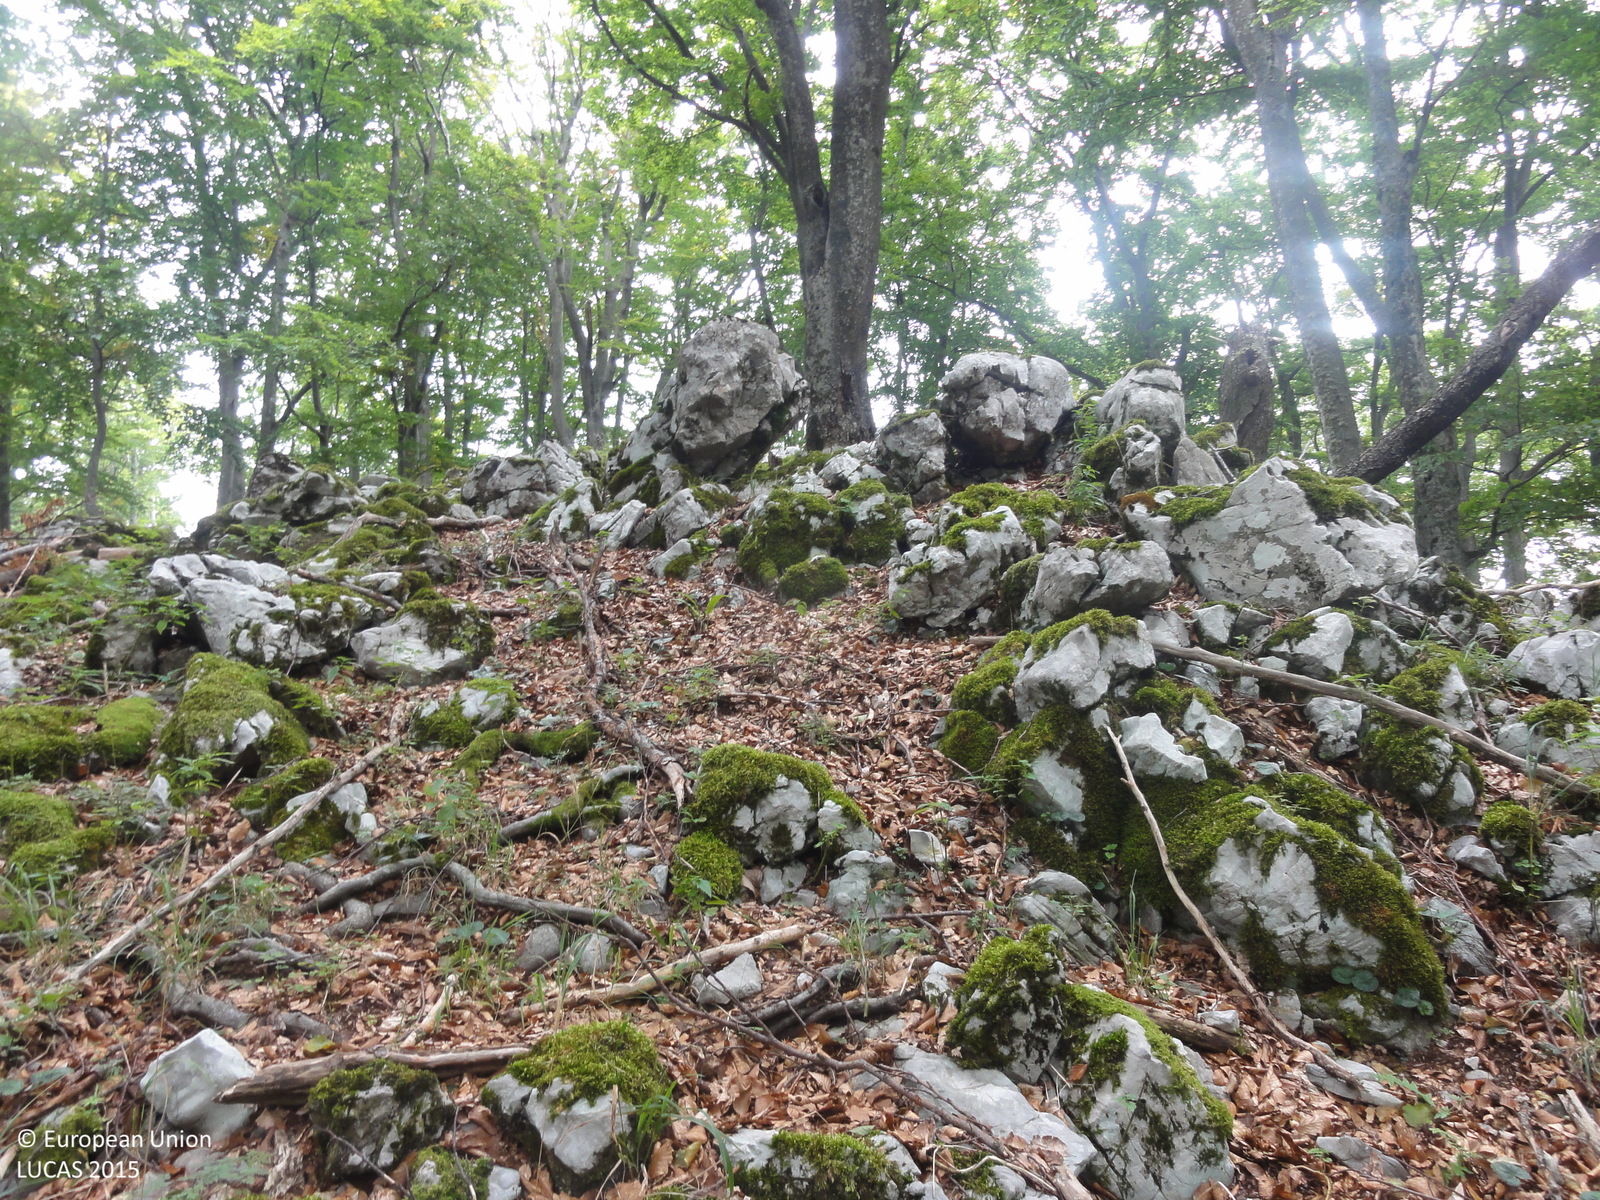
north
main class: Woodland
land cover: Broadleaved woodland
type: mountainous beech forest
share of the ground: > 75 %
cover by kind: broadleaved forest trees 95 %, consolidated bare surface 5 %
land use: Forestry
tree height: > 5 m
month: September
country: SI
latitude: 45.6034
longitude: 14.9833
